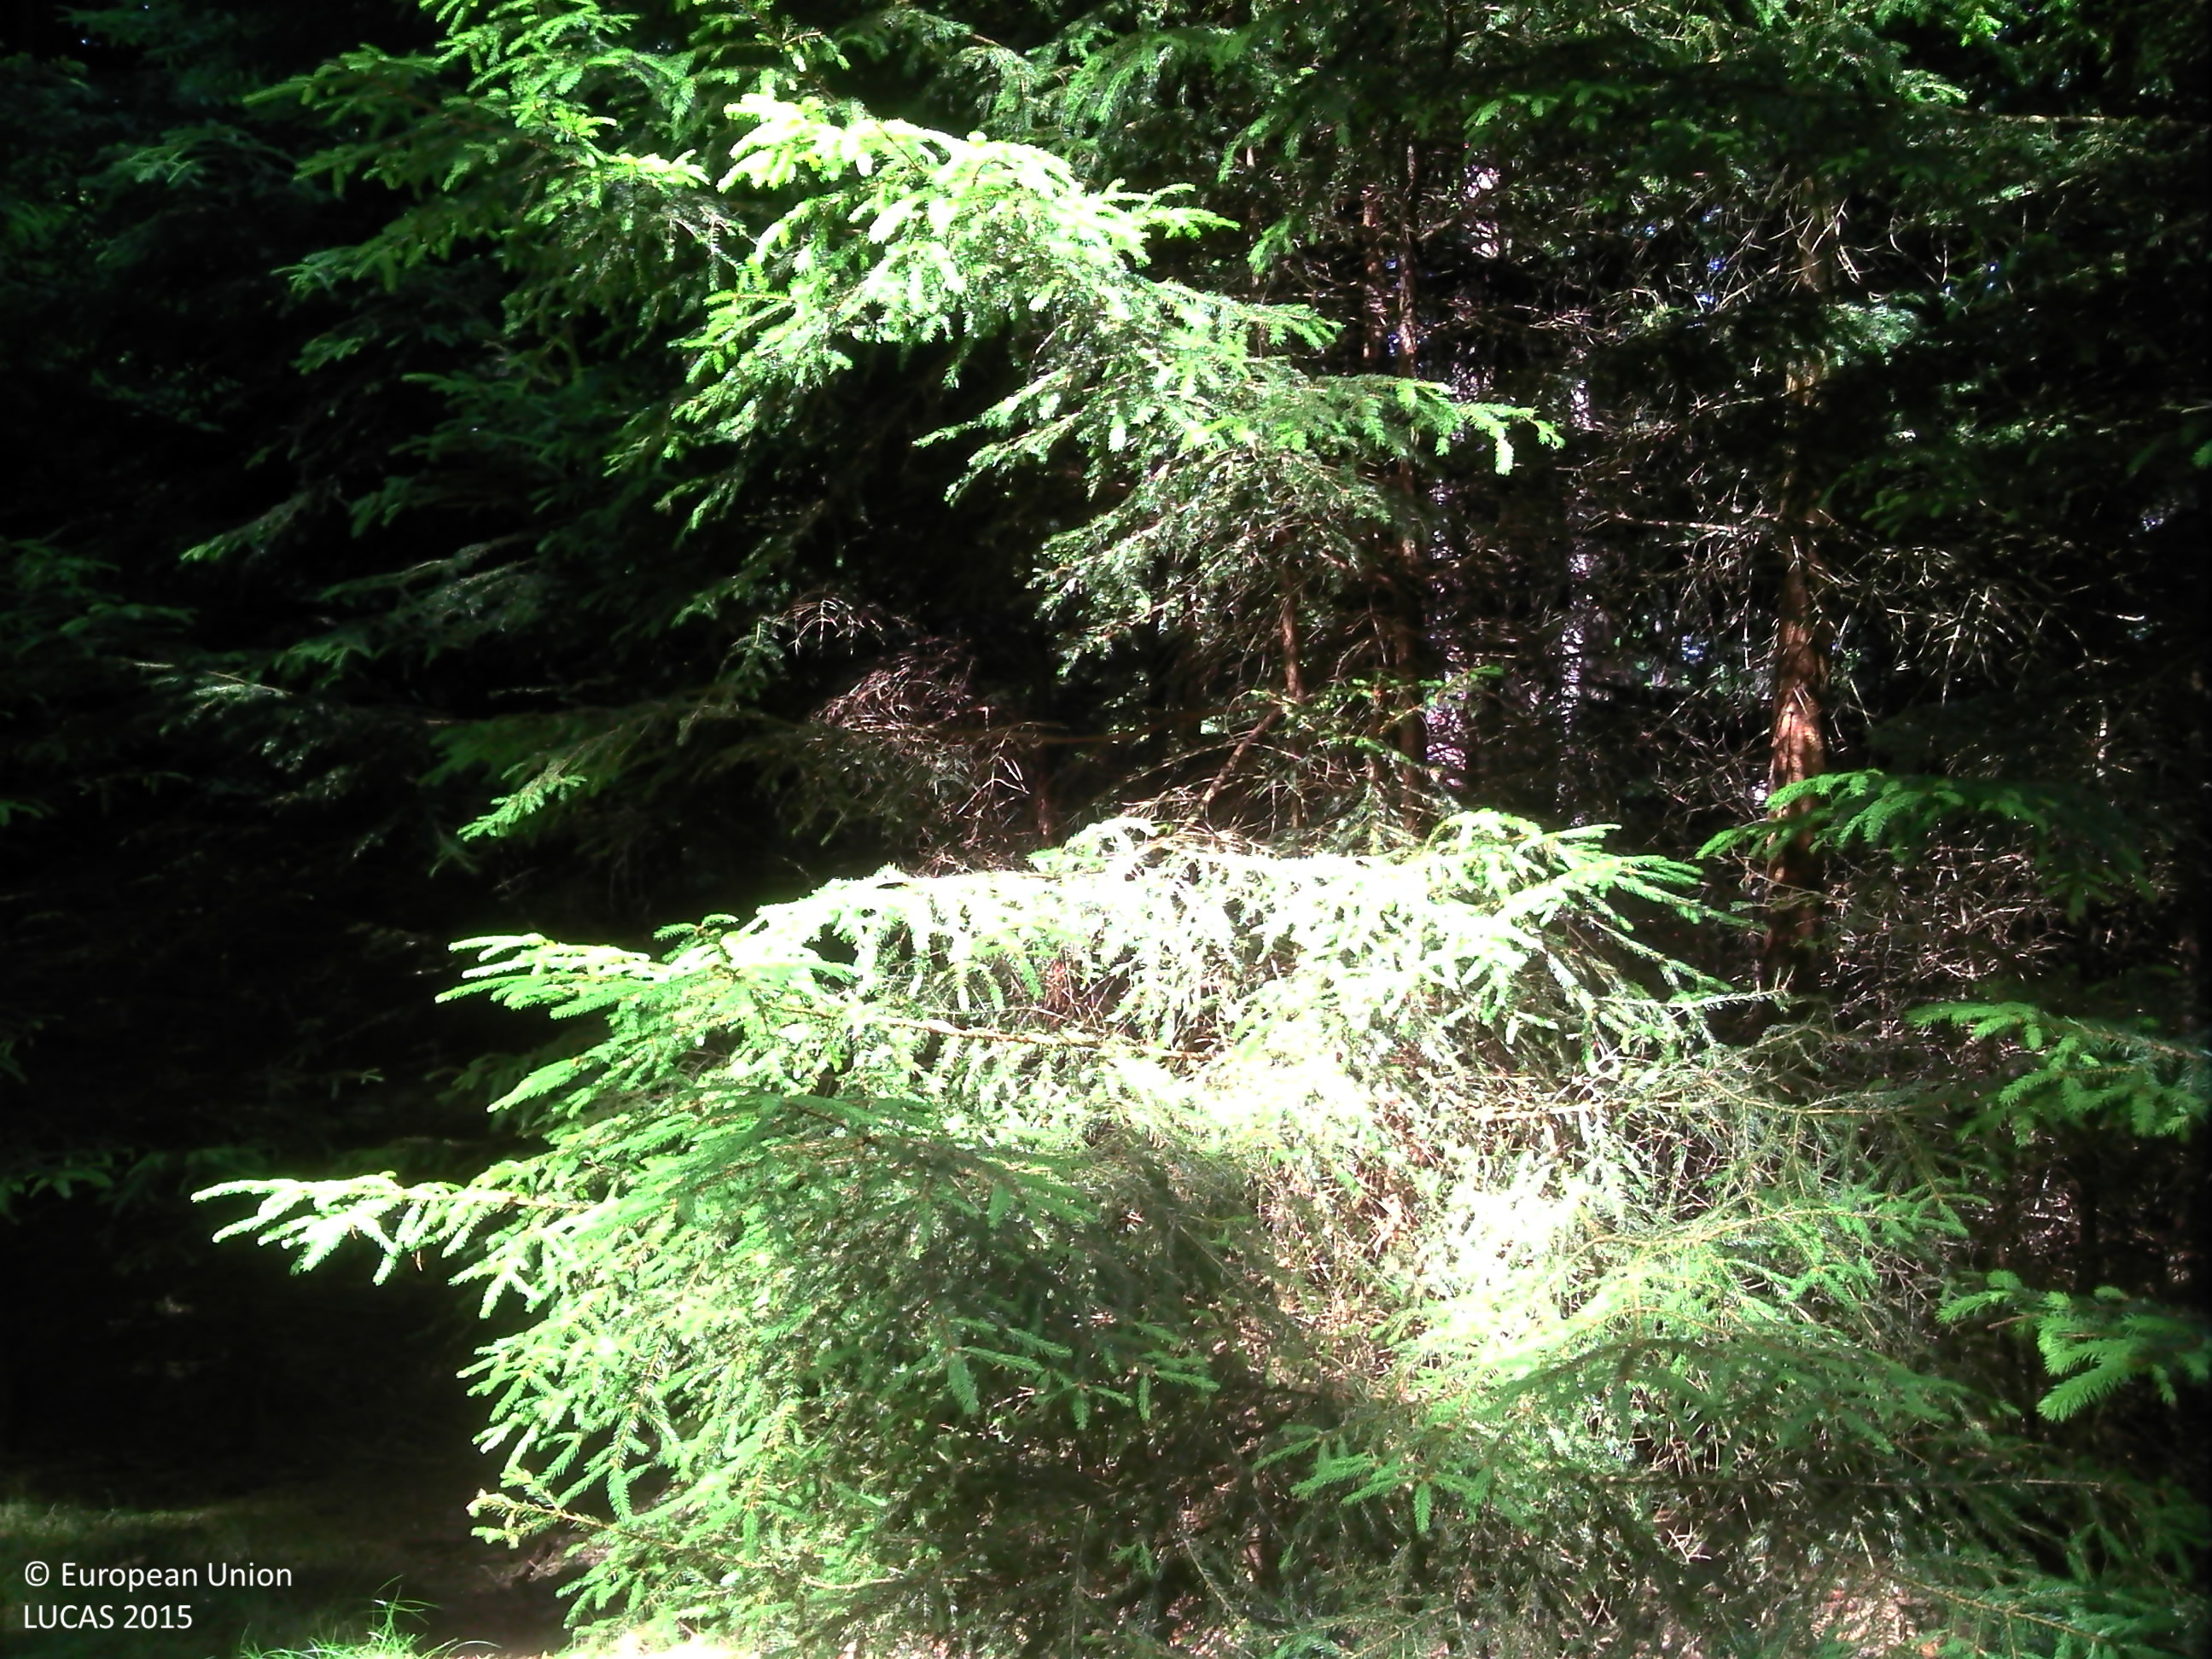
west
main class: Woodland
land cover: Spruce dominated coniferous woodland
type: exotic forest
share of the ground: > 75 %
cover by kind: coniferous forest trees 90 %, herbaceous plants 5 %, lichens and mosses 5 %
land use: Forestry
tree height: > 5 m
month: June
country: BE
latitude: 50.4296
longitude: 5.7614
